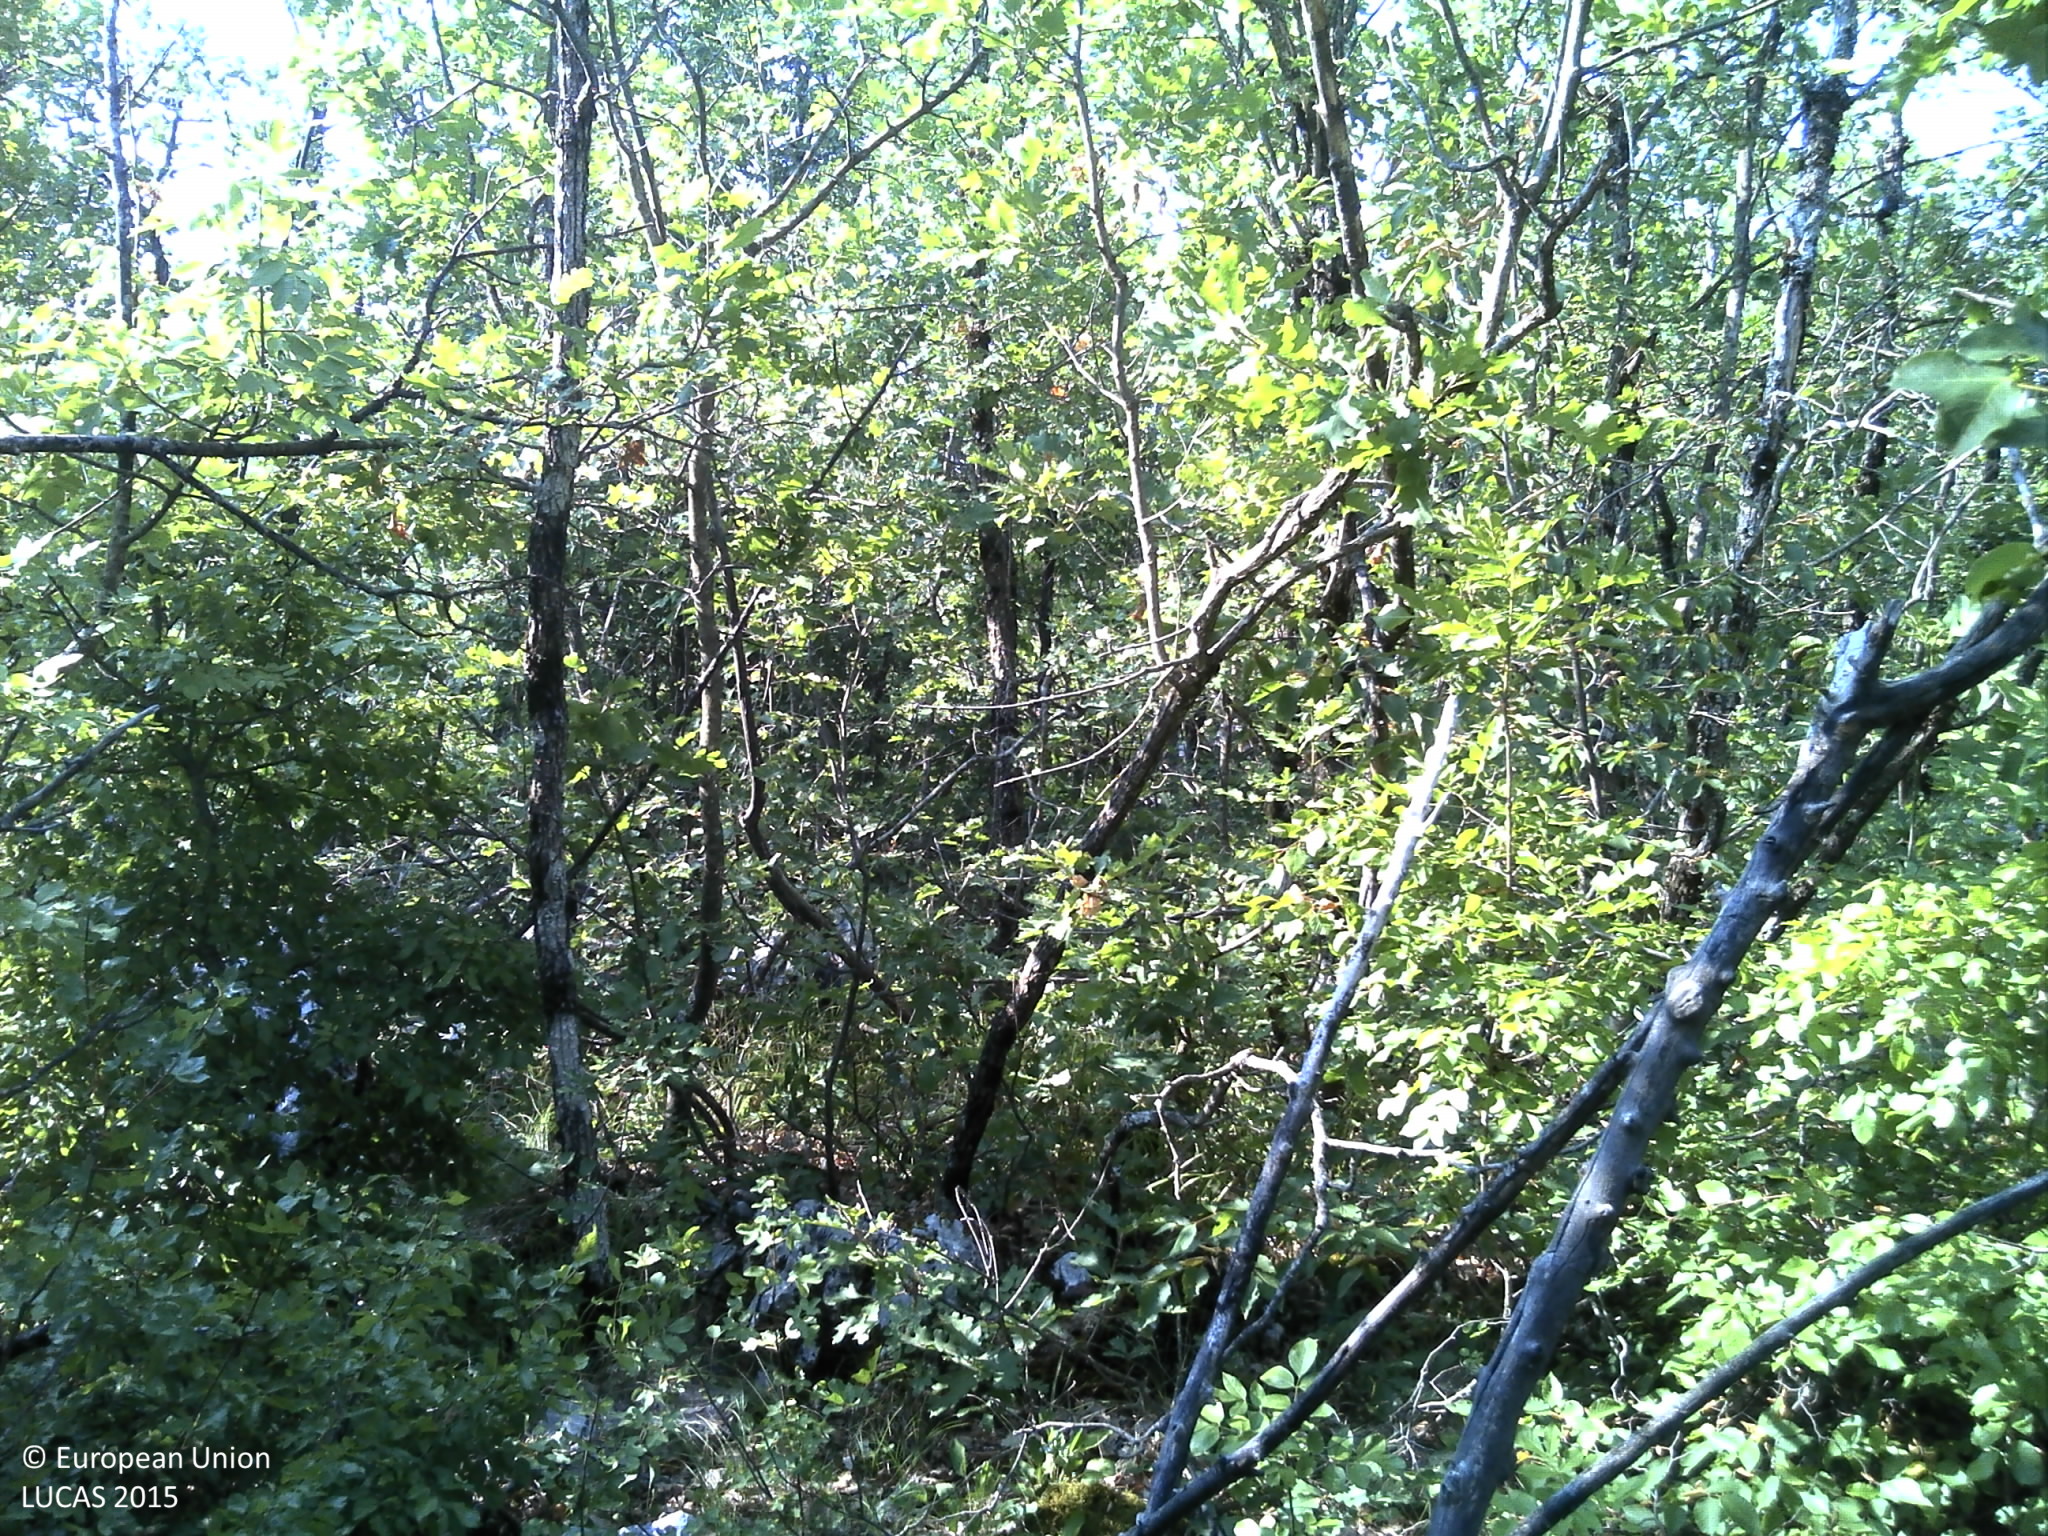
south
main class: Woodland
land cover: Broadleaved woodland
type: thermophilous deciduous forest
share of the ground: > 75 %
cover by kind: broadleaved forest trees 75 %, shrubs 15 %, herbaceous plants 5 %, consolidated bare surface 5 %
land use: Semi-natural and natural areas not in use
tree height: > 5 m
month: July
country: HR
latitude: 43.3820
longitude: 17.1136
